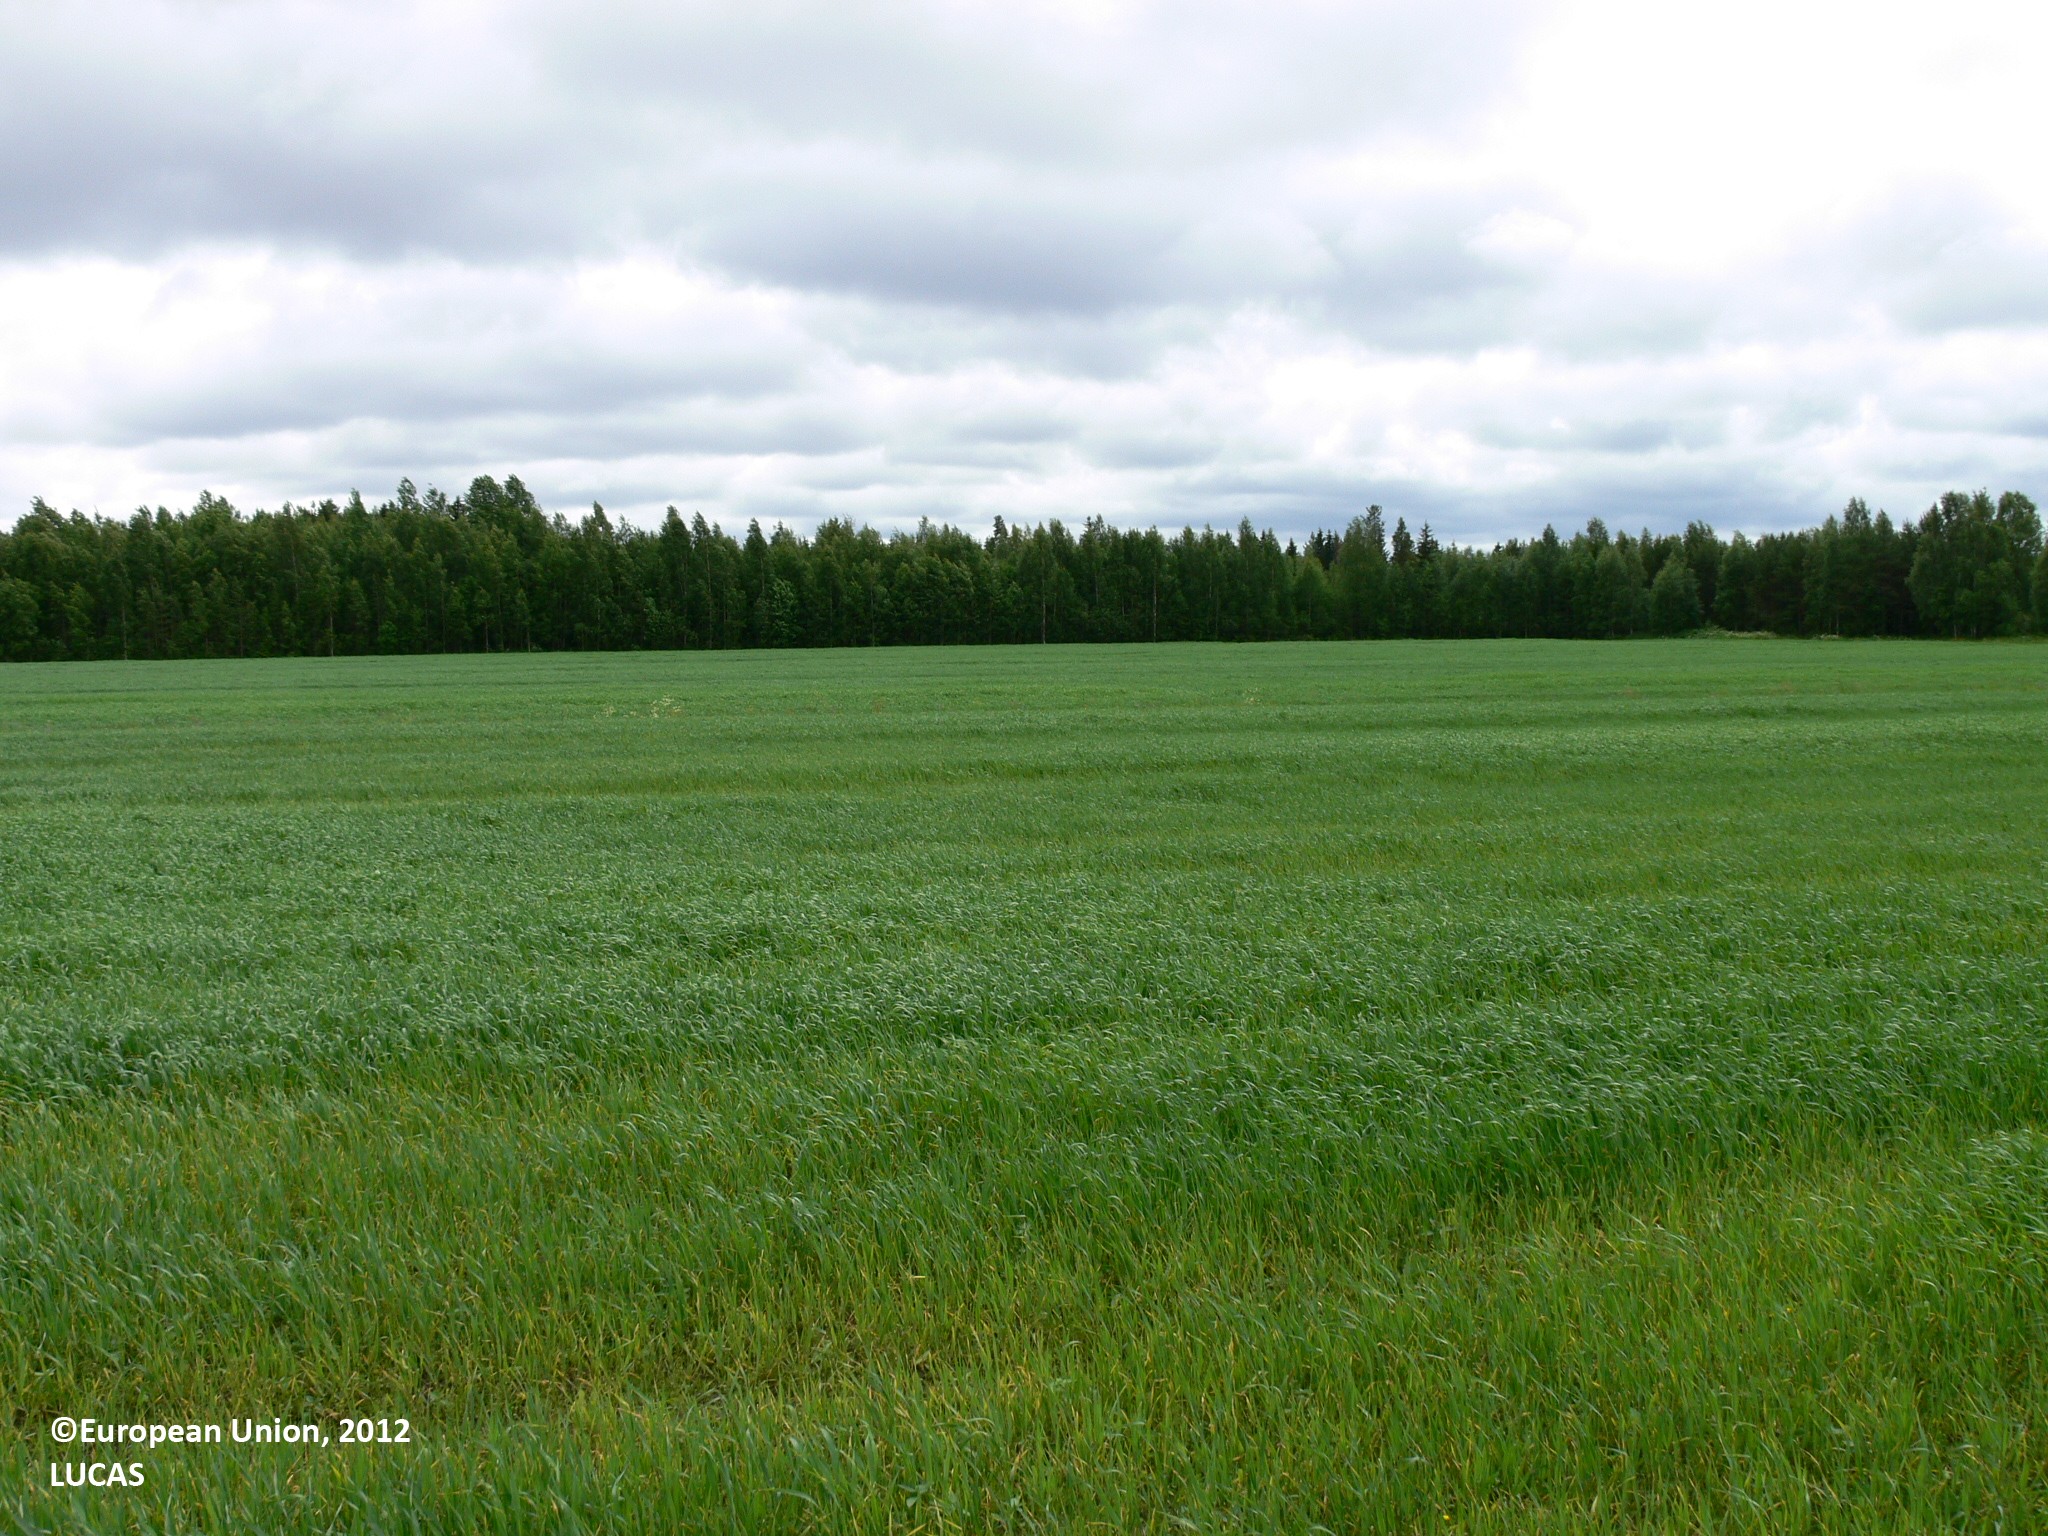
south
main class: Cropland
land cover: Barley
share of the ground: > 75 %
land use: Agriculture (excluding fallow land and kitchen gardens)
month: June
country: FI
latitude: 62.8216
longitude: 29.2819
